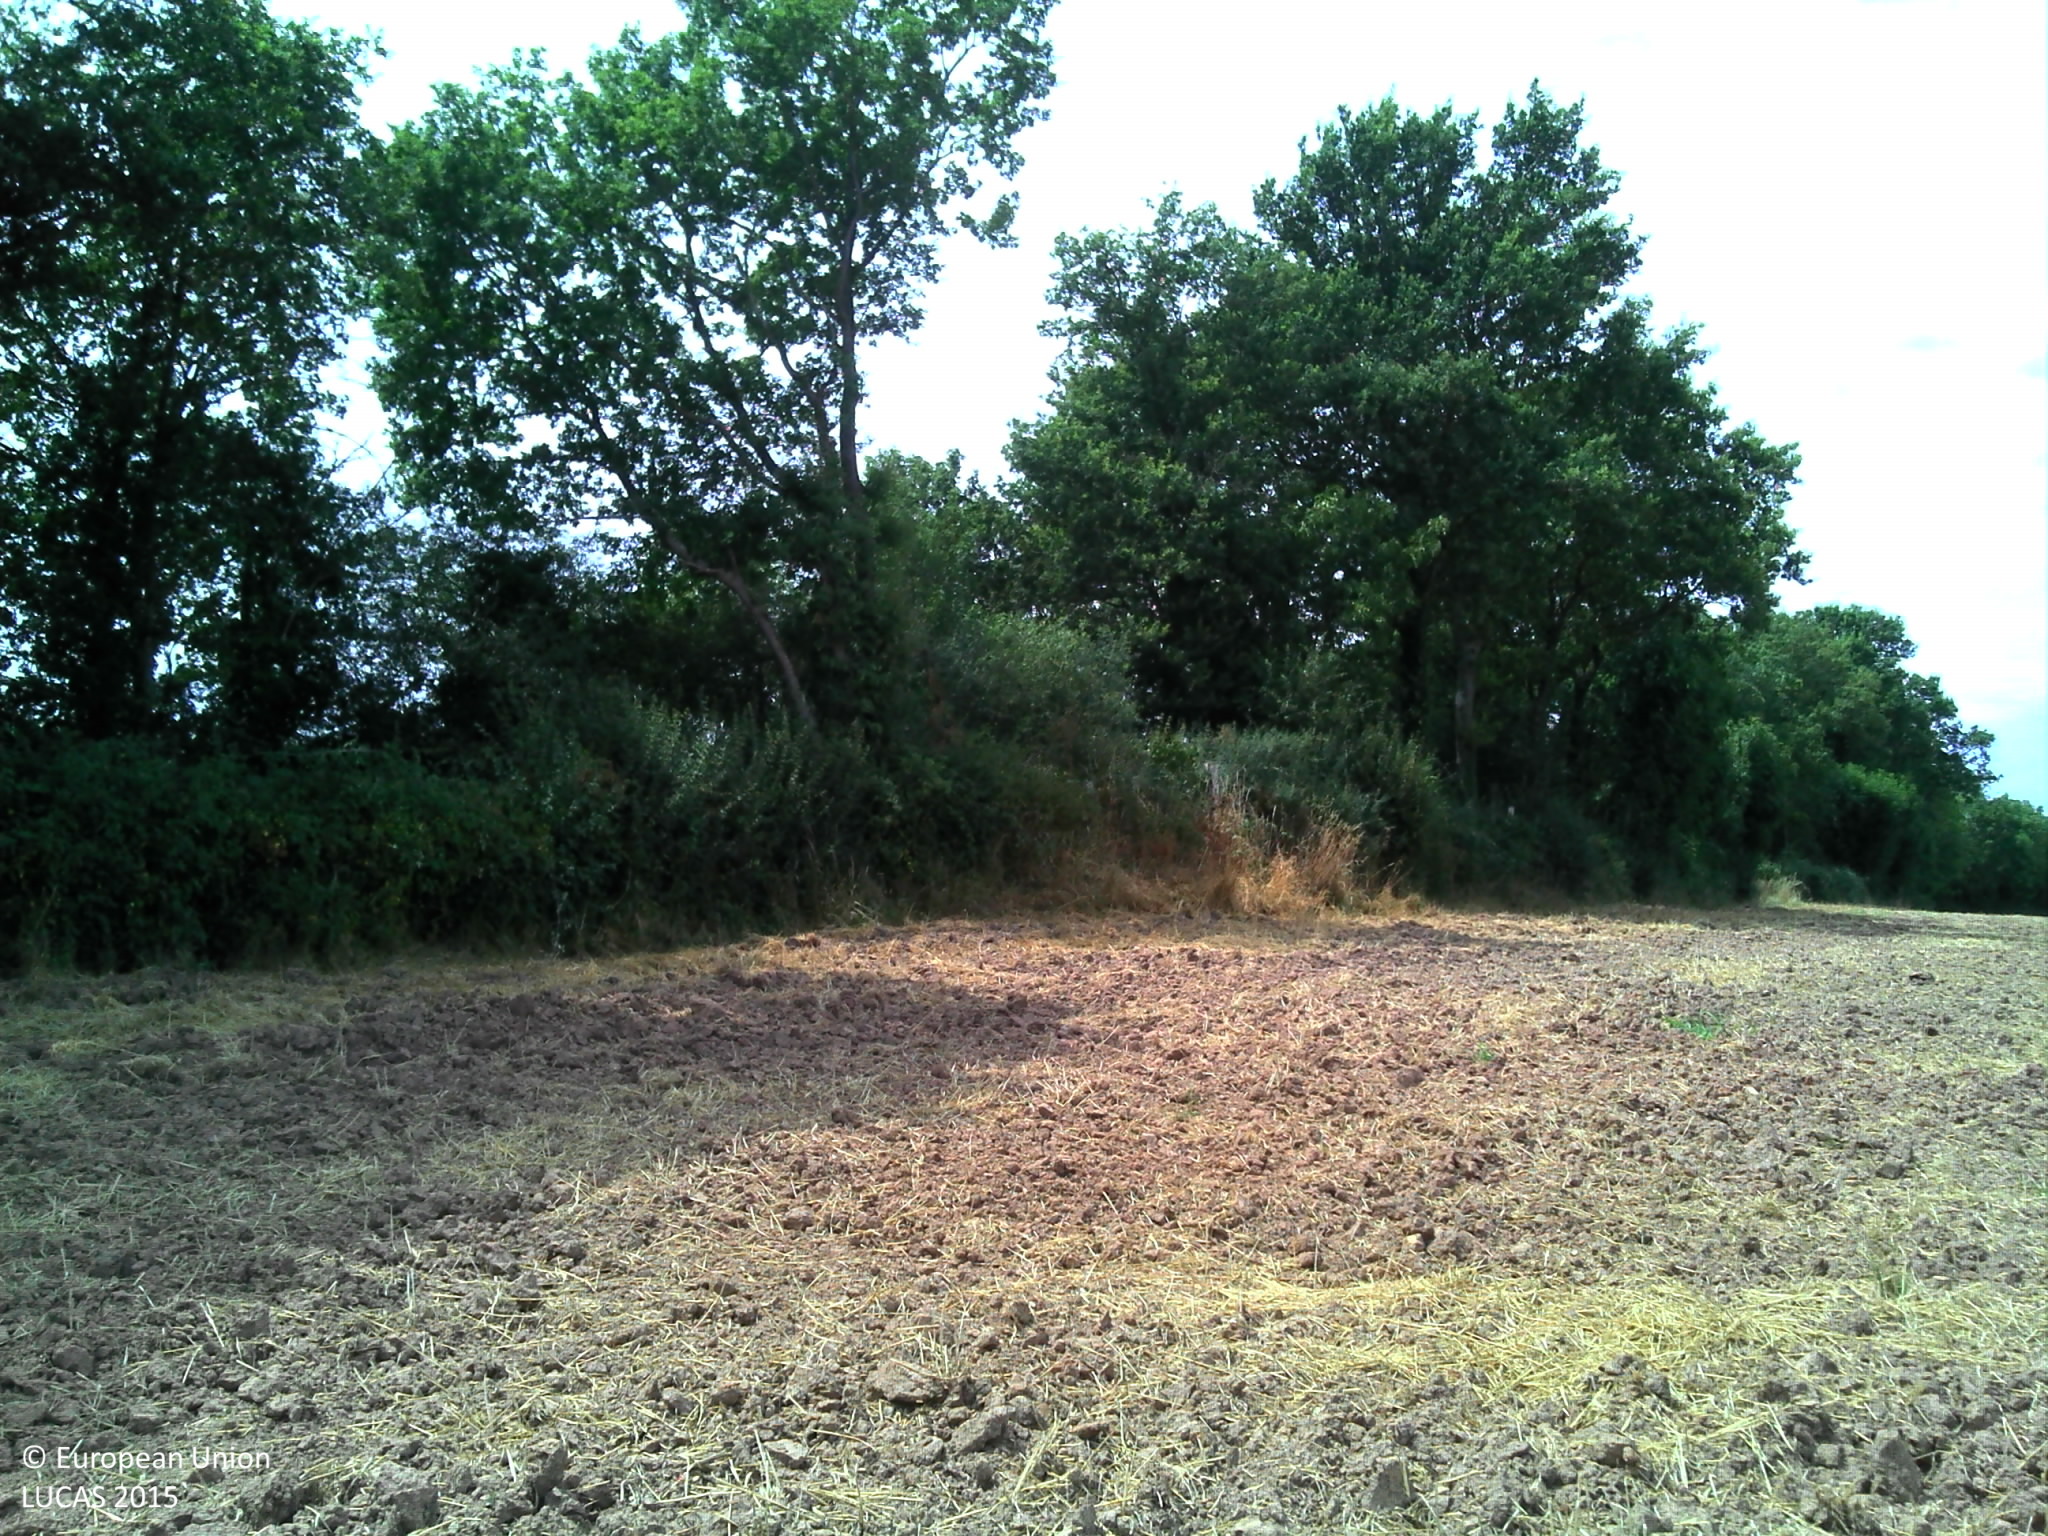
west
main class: Cropland
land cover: Barley
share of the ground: > 75 %
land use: Agriculture (excluding fallow land and kitchen gardens)
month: July
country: FR
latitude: 46.6071
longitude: 2.9595
